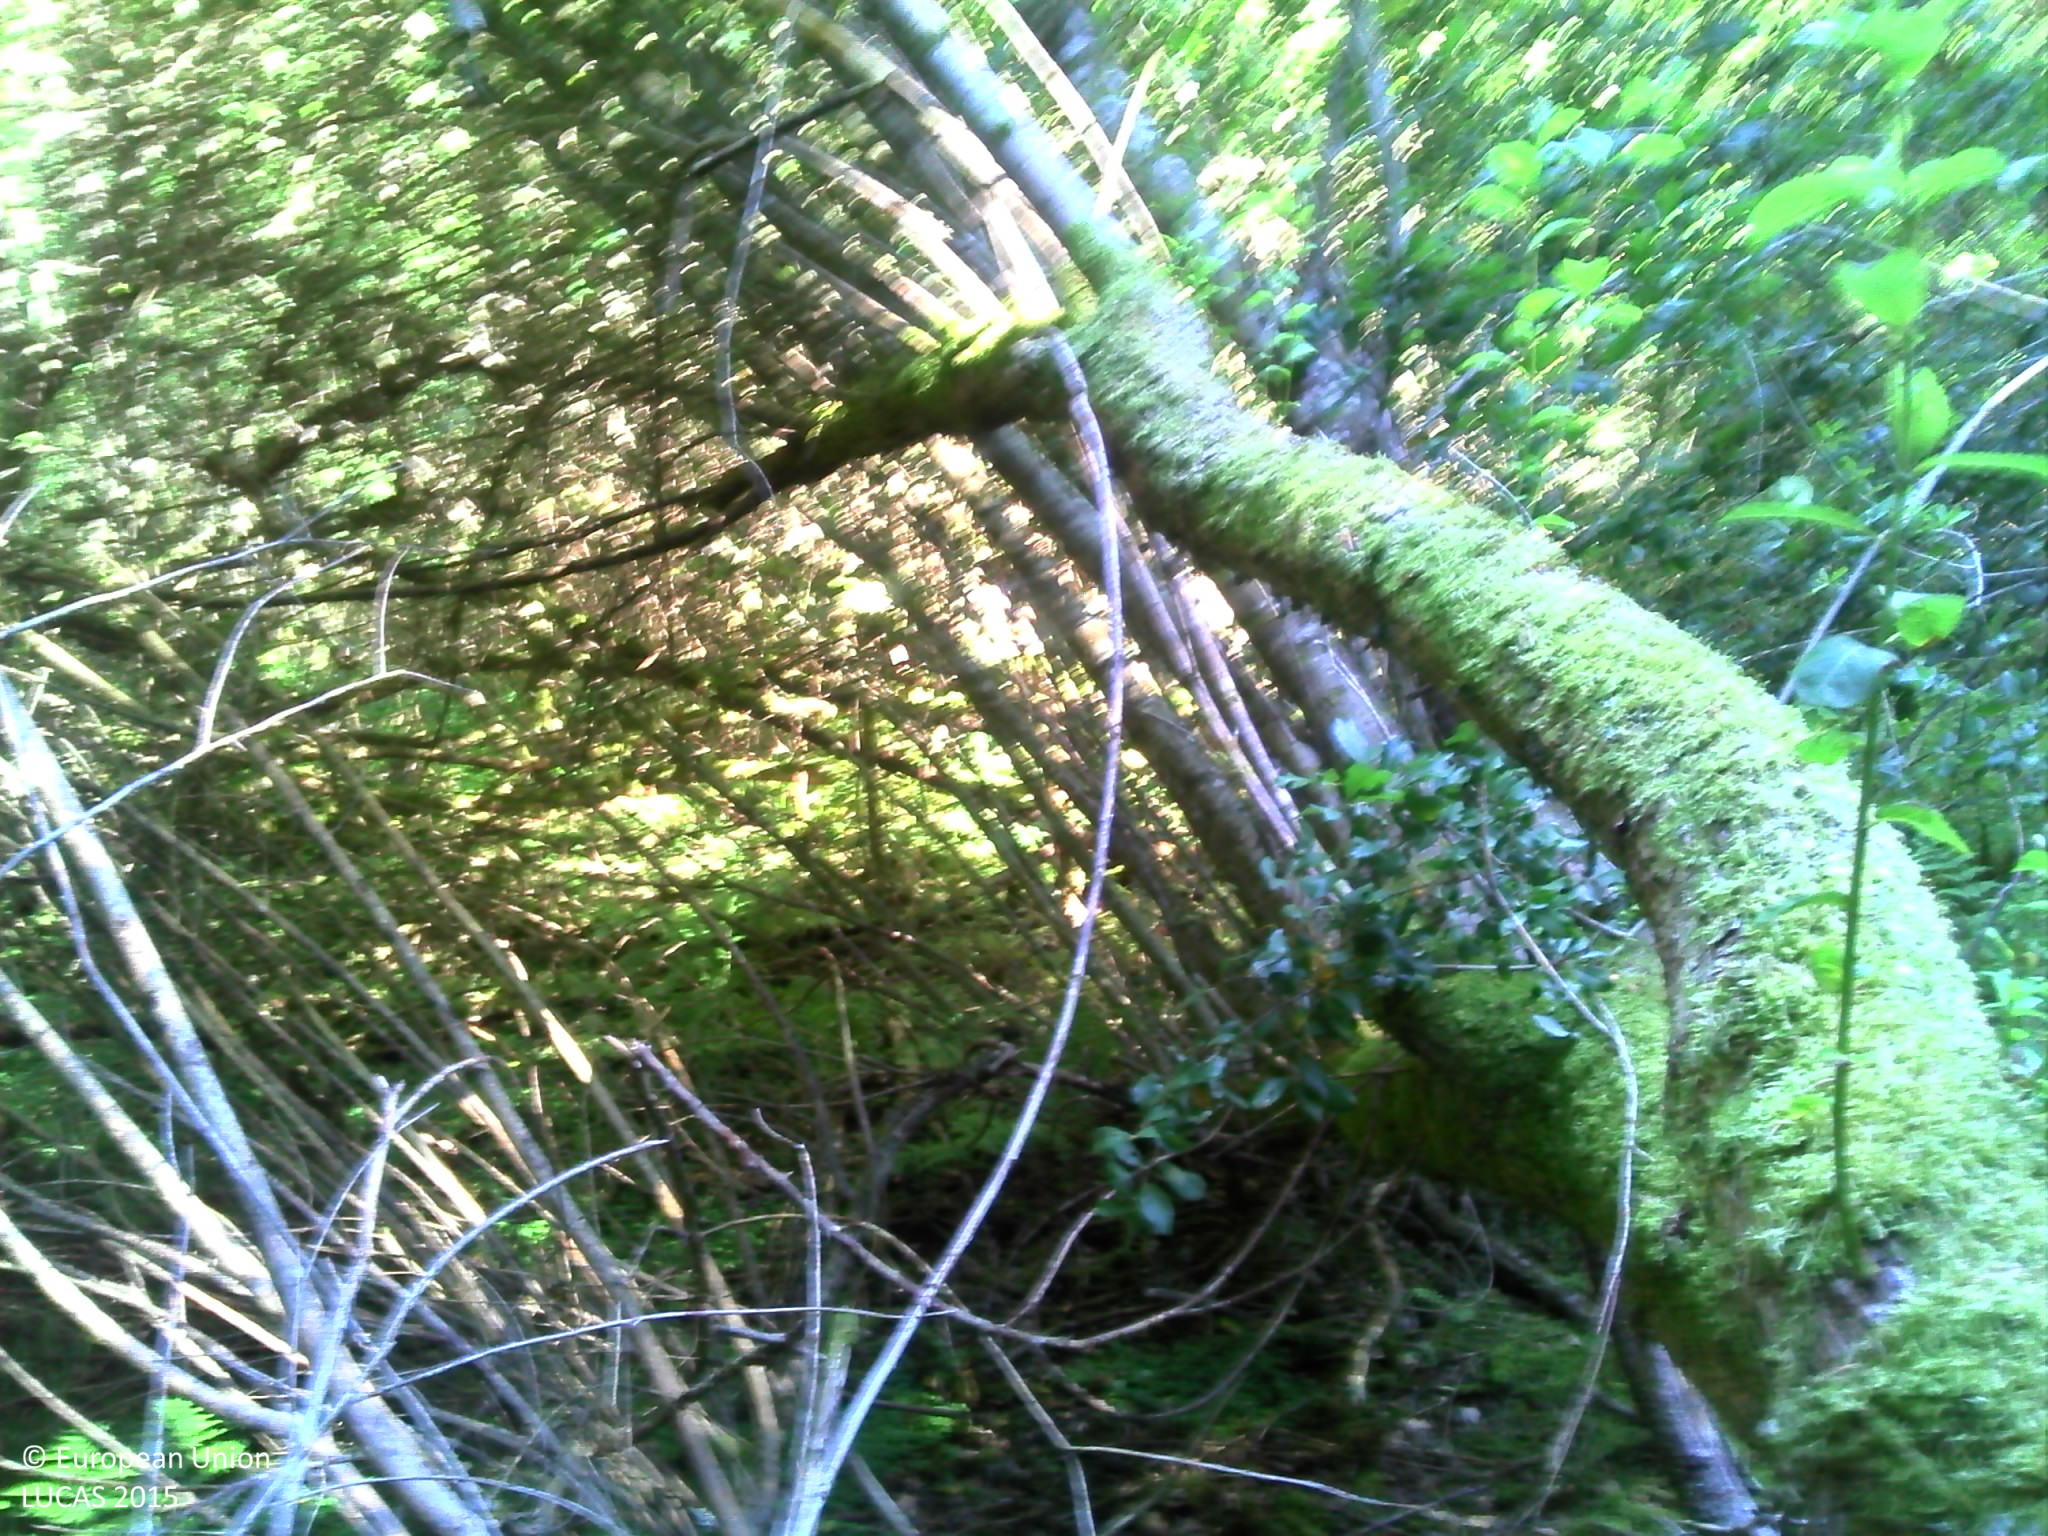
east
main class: Woodland
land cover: Broadleaved woodland
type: acidophilous oak and oak-birch forest
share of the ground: > 75 %
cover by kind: broadleaved forest trees 70 %, shrubs 10 %, herbaceous plants 10 %, lichens and mosses 10 %
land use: Forestry
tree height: > 5 m
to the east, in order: Broadleaved woodland; Ponds and wetlands; Broadleaved woodland; Inland marshes; Broadleaved woodland; Rivers and streams; Broadleaved woodland; Shrubland with sparse tree cover; Tracks; Shrubland with sparse tree cover; Electric lines; Spontaneously vegetated surfaces; Fences; Spontaneously vegetated surfaces
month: August
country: FR
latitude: 45.8363
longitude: 1.7928
